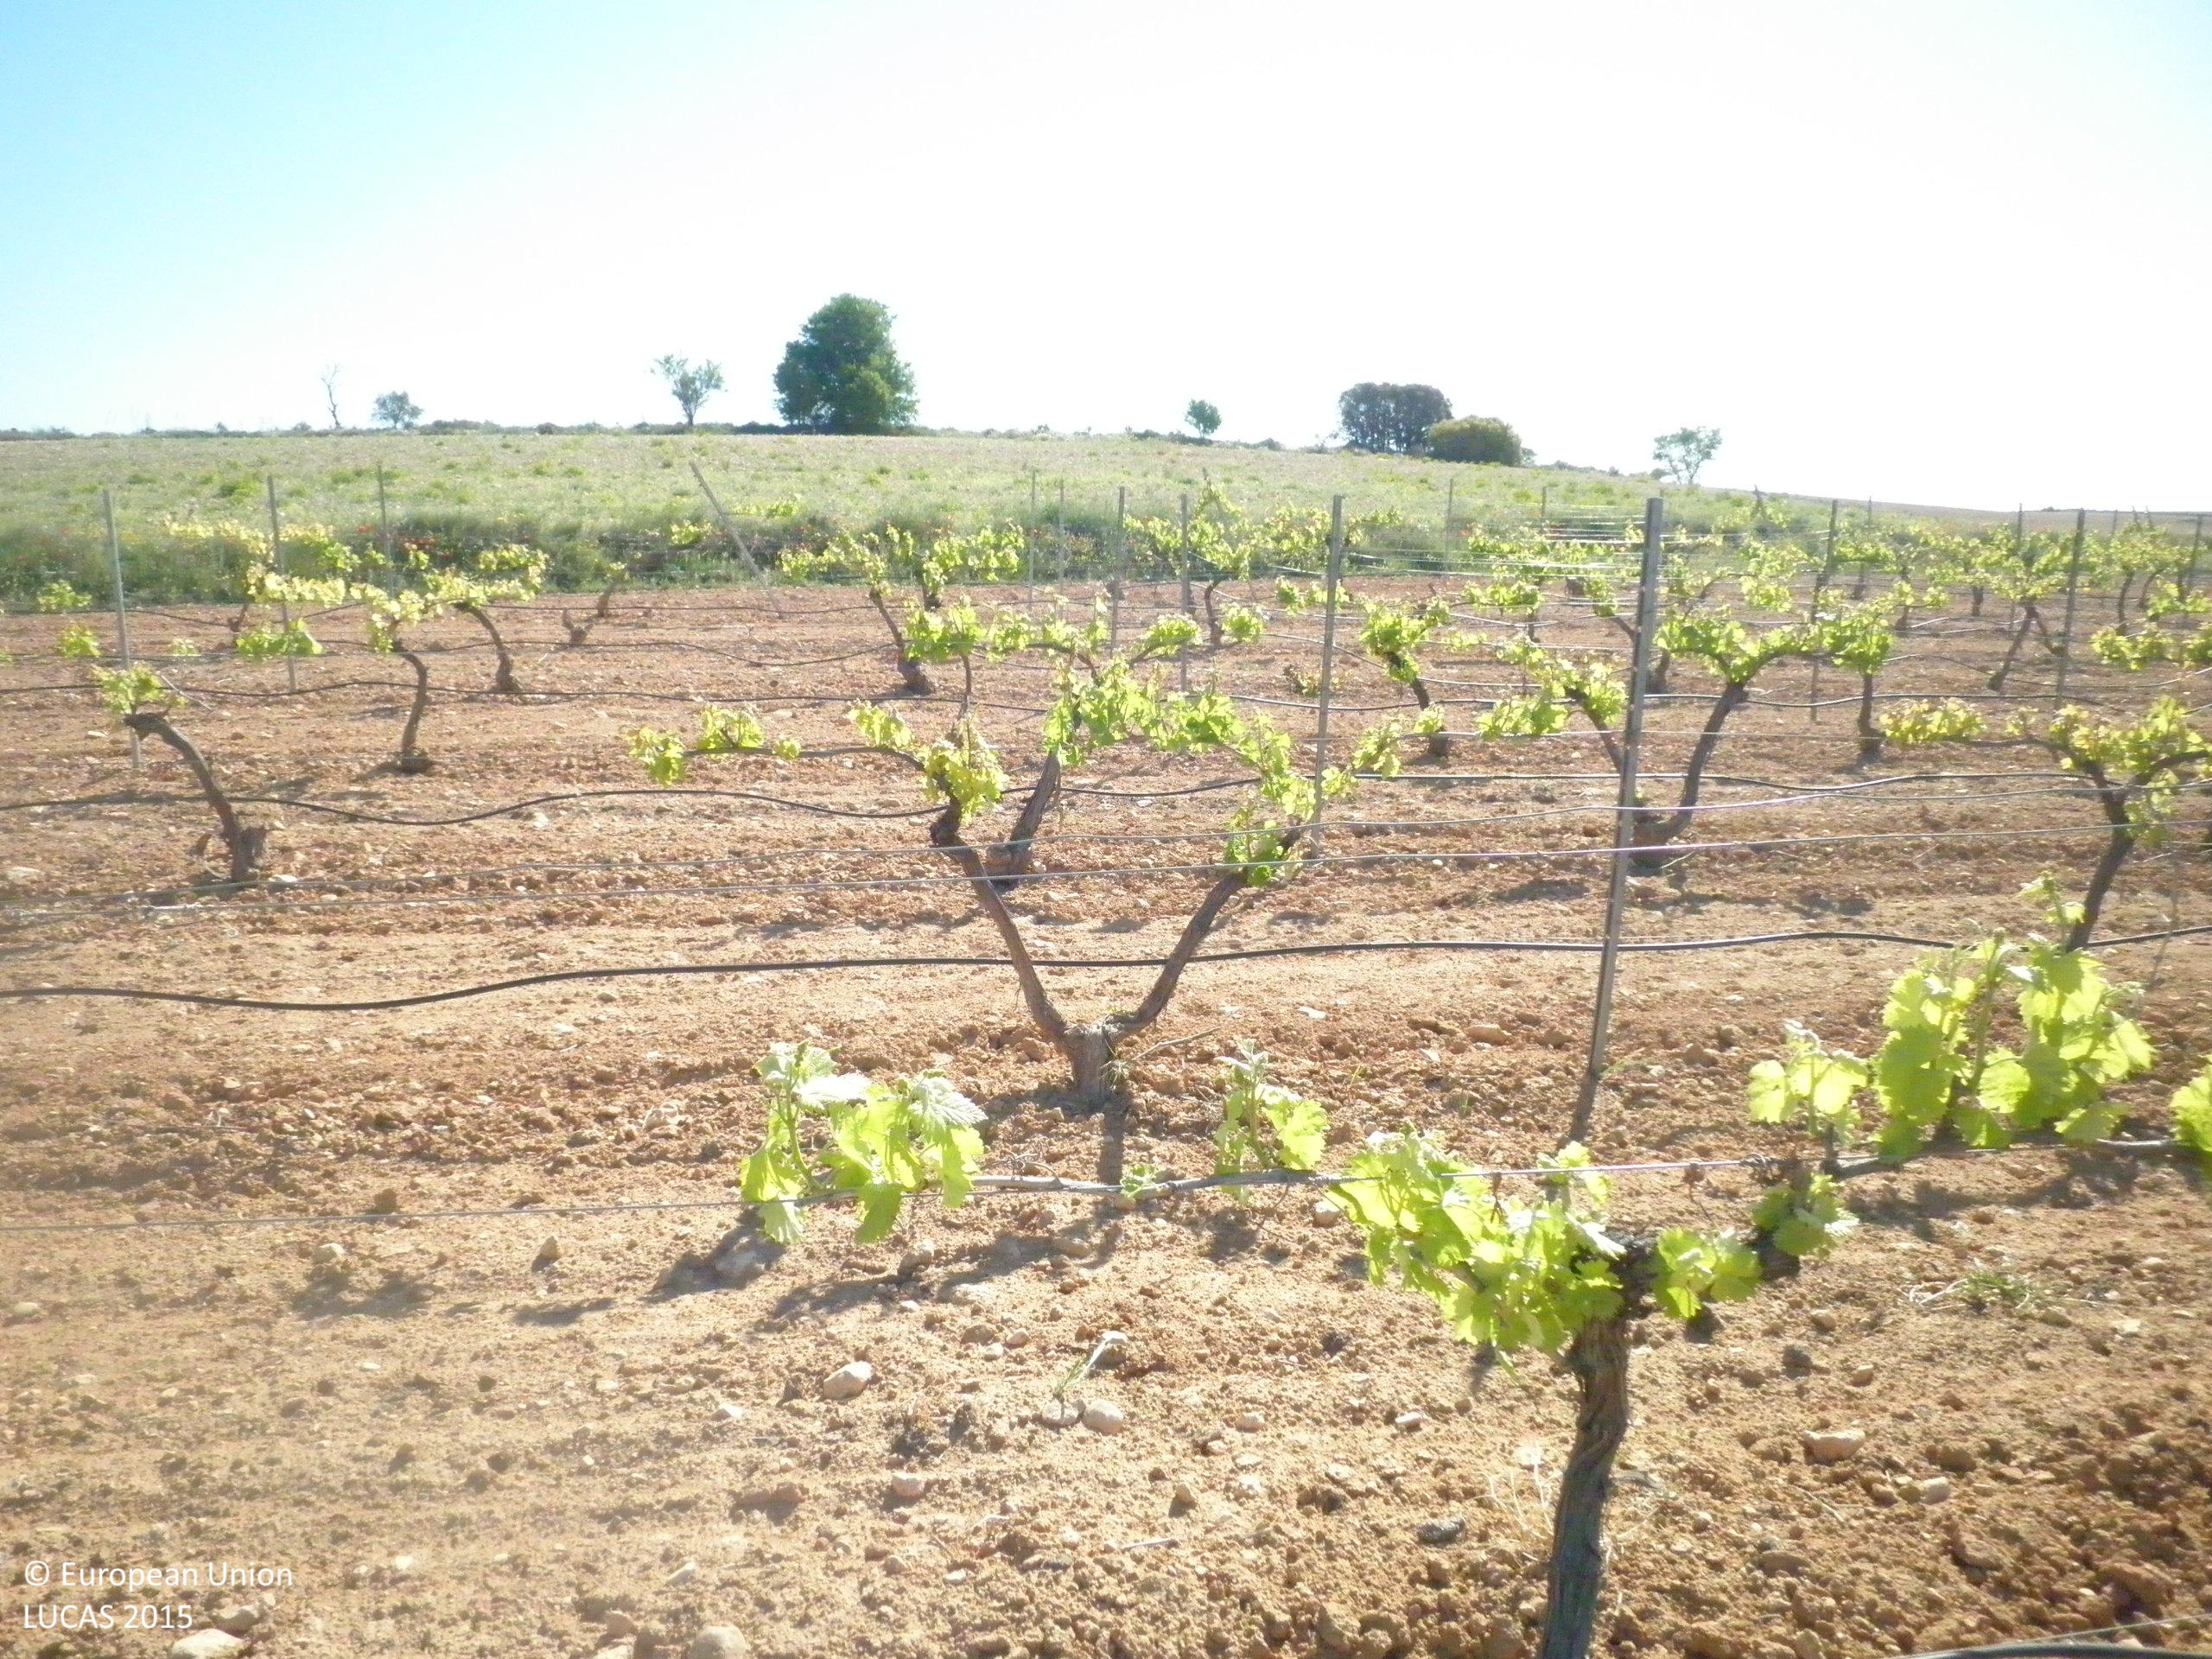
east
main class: Cropland
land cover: Vineyards
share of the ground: < 10 %
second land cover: Other bare soil
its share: > 75 %
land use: Agriculture (excluding fallow land and kitchen gardens)
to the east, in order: Vineyards; Other bare soil; Grass margins; Spontaneously vegetated surfaces; Shrubland with sparse tree cover; Barley; Grass margins; Tracks; Grass margins; Olive groves; Grassland without tree/shrub cover; Olive groves
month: May
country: ES
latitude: 39.4664
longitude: -2.7650
